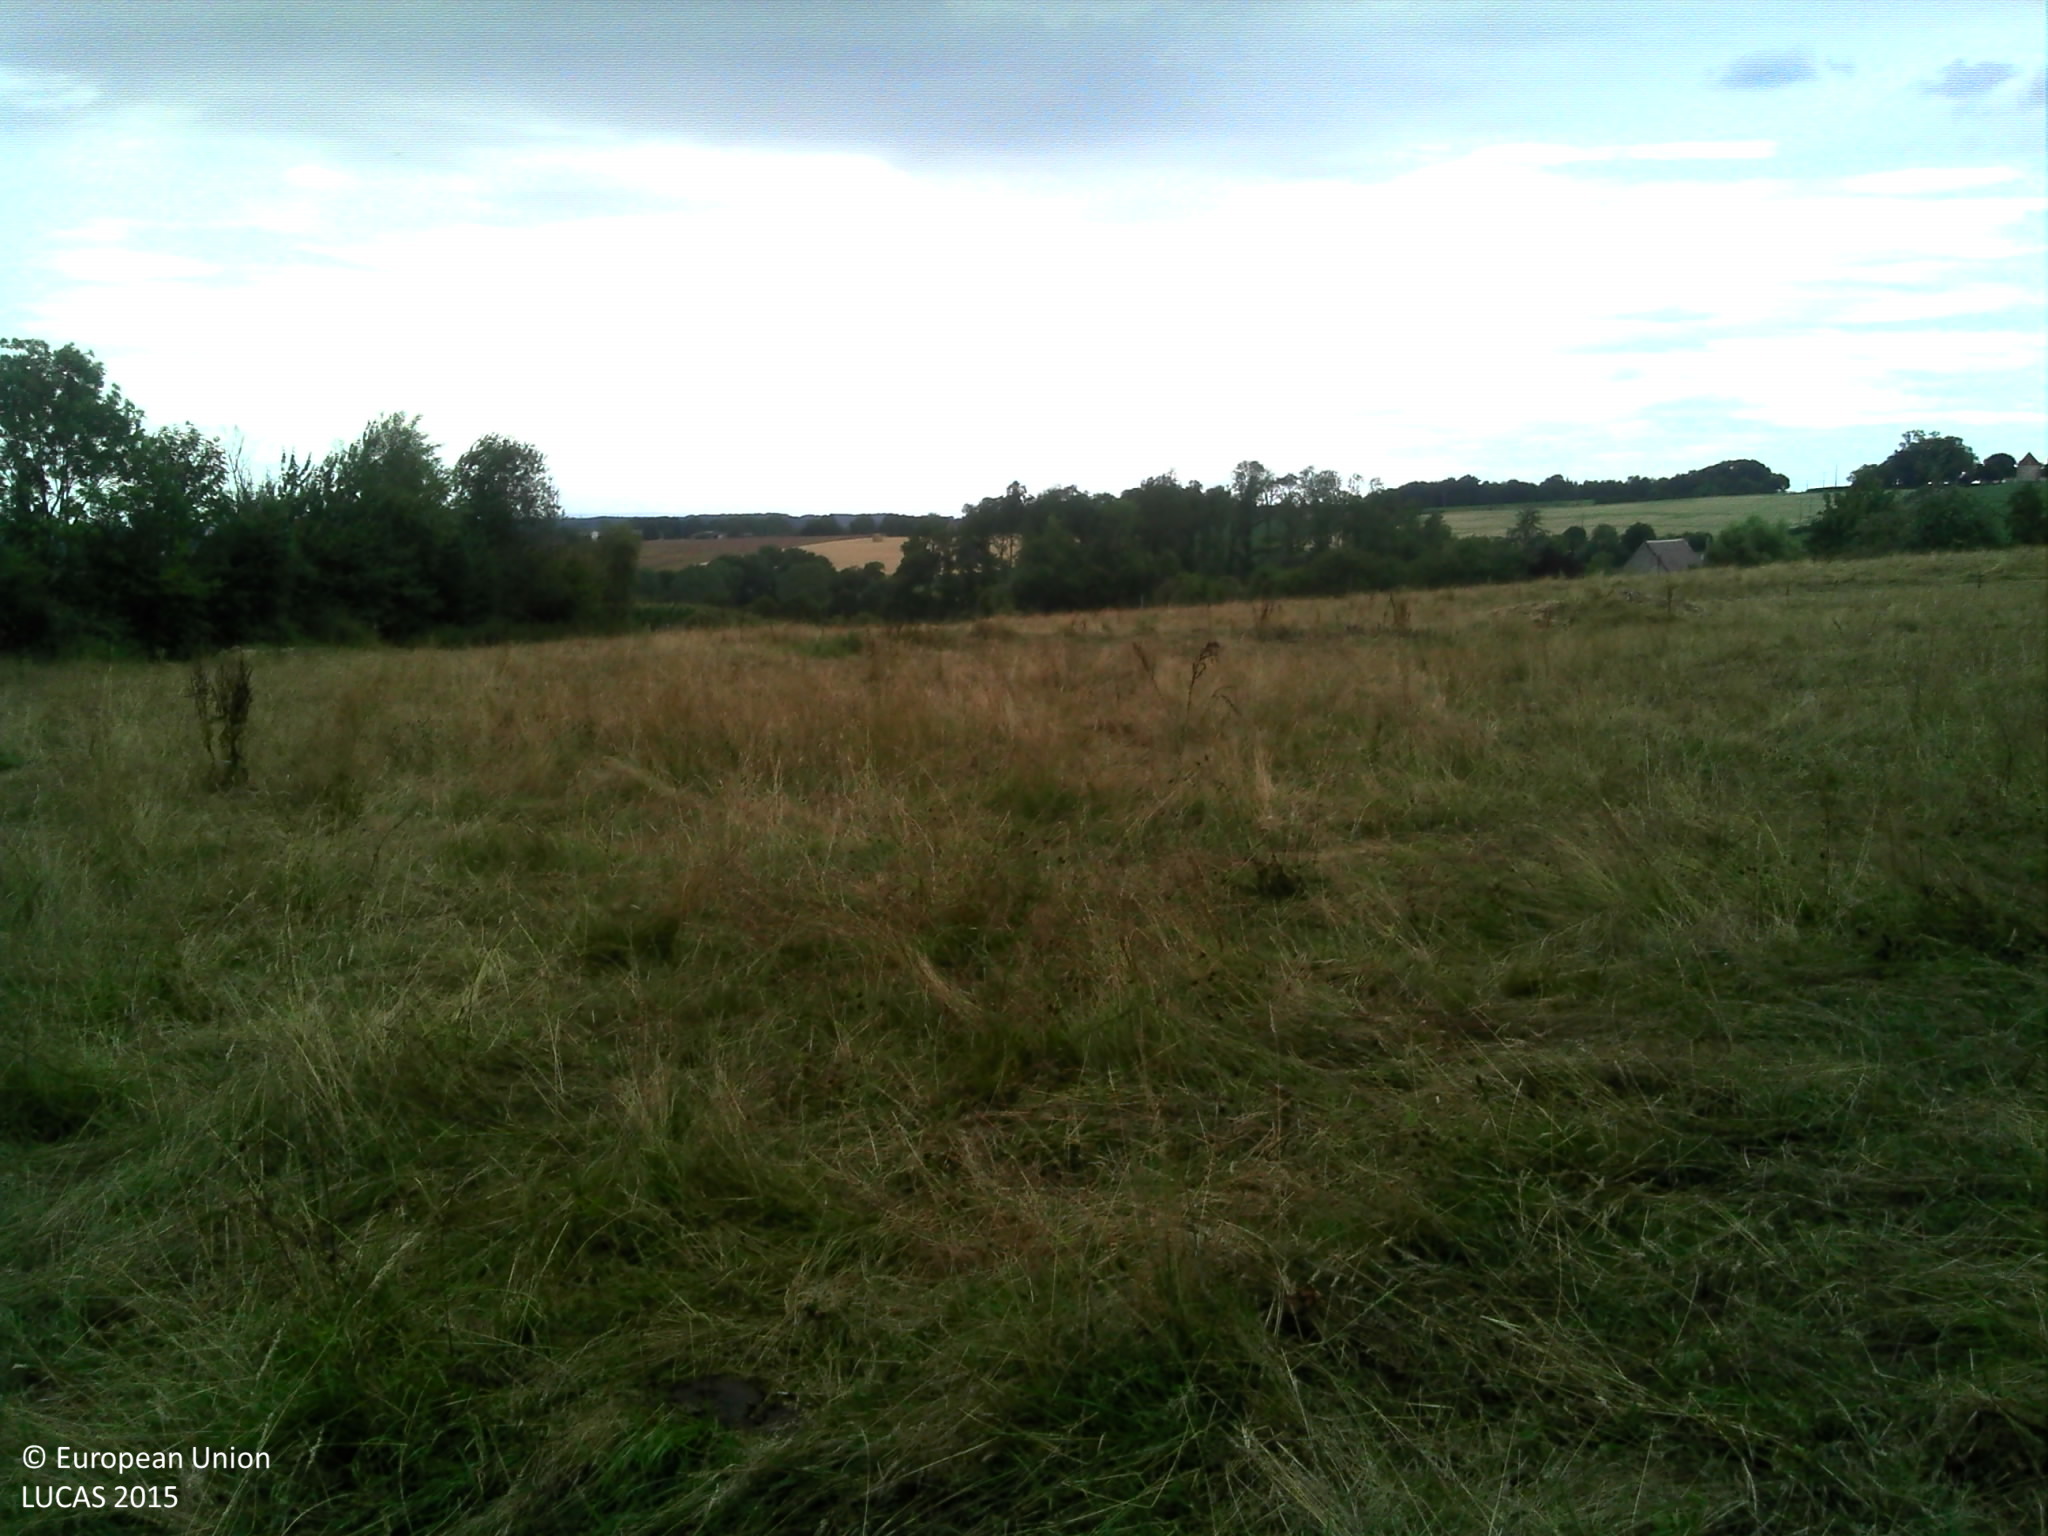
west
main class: Grassland
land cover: Grassland without tree/shrub cover
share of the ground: > 75 %
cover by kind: herbaceous plants 100 %
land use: Agriculture (excluding fallow land and kitchen gardens)
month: July
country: FR
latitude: 48.5757
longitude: 0.5282
